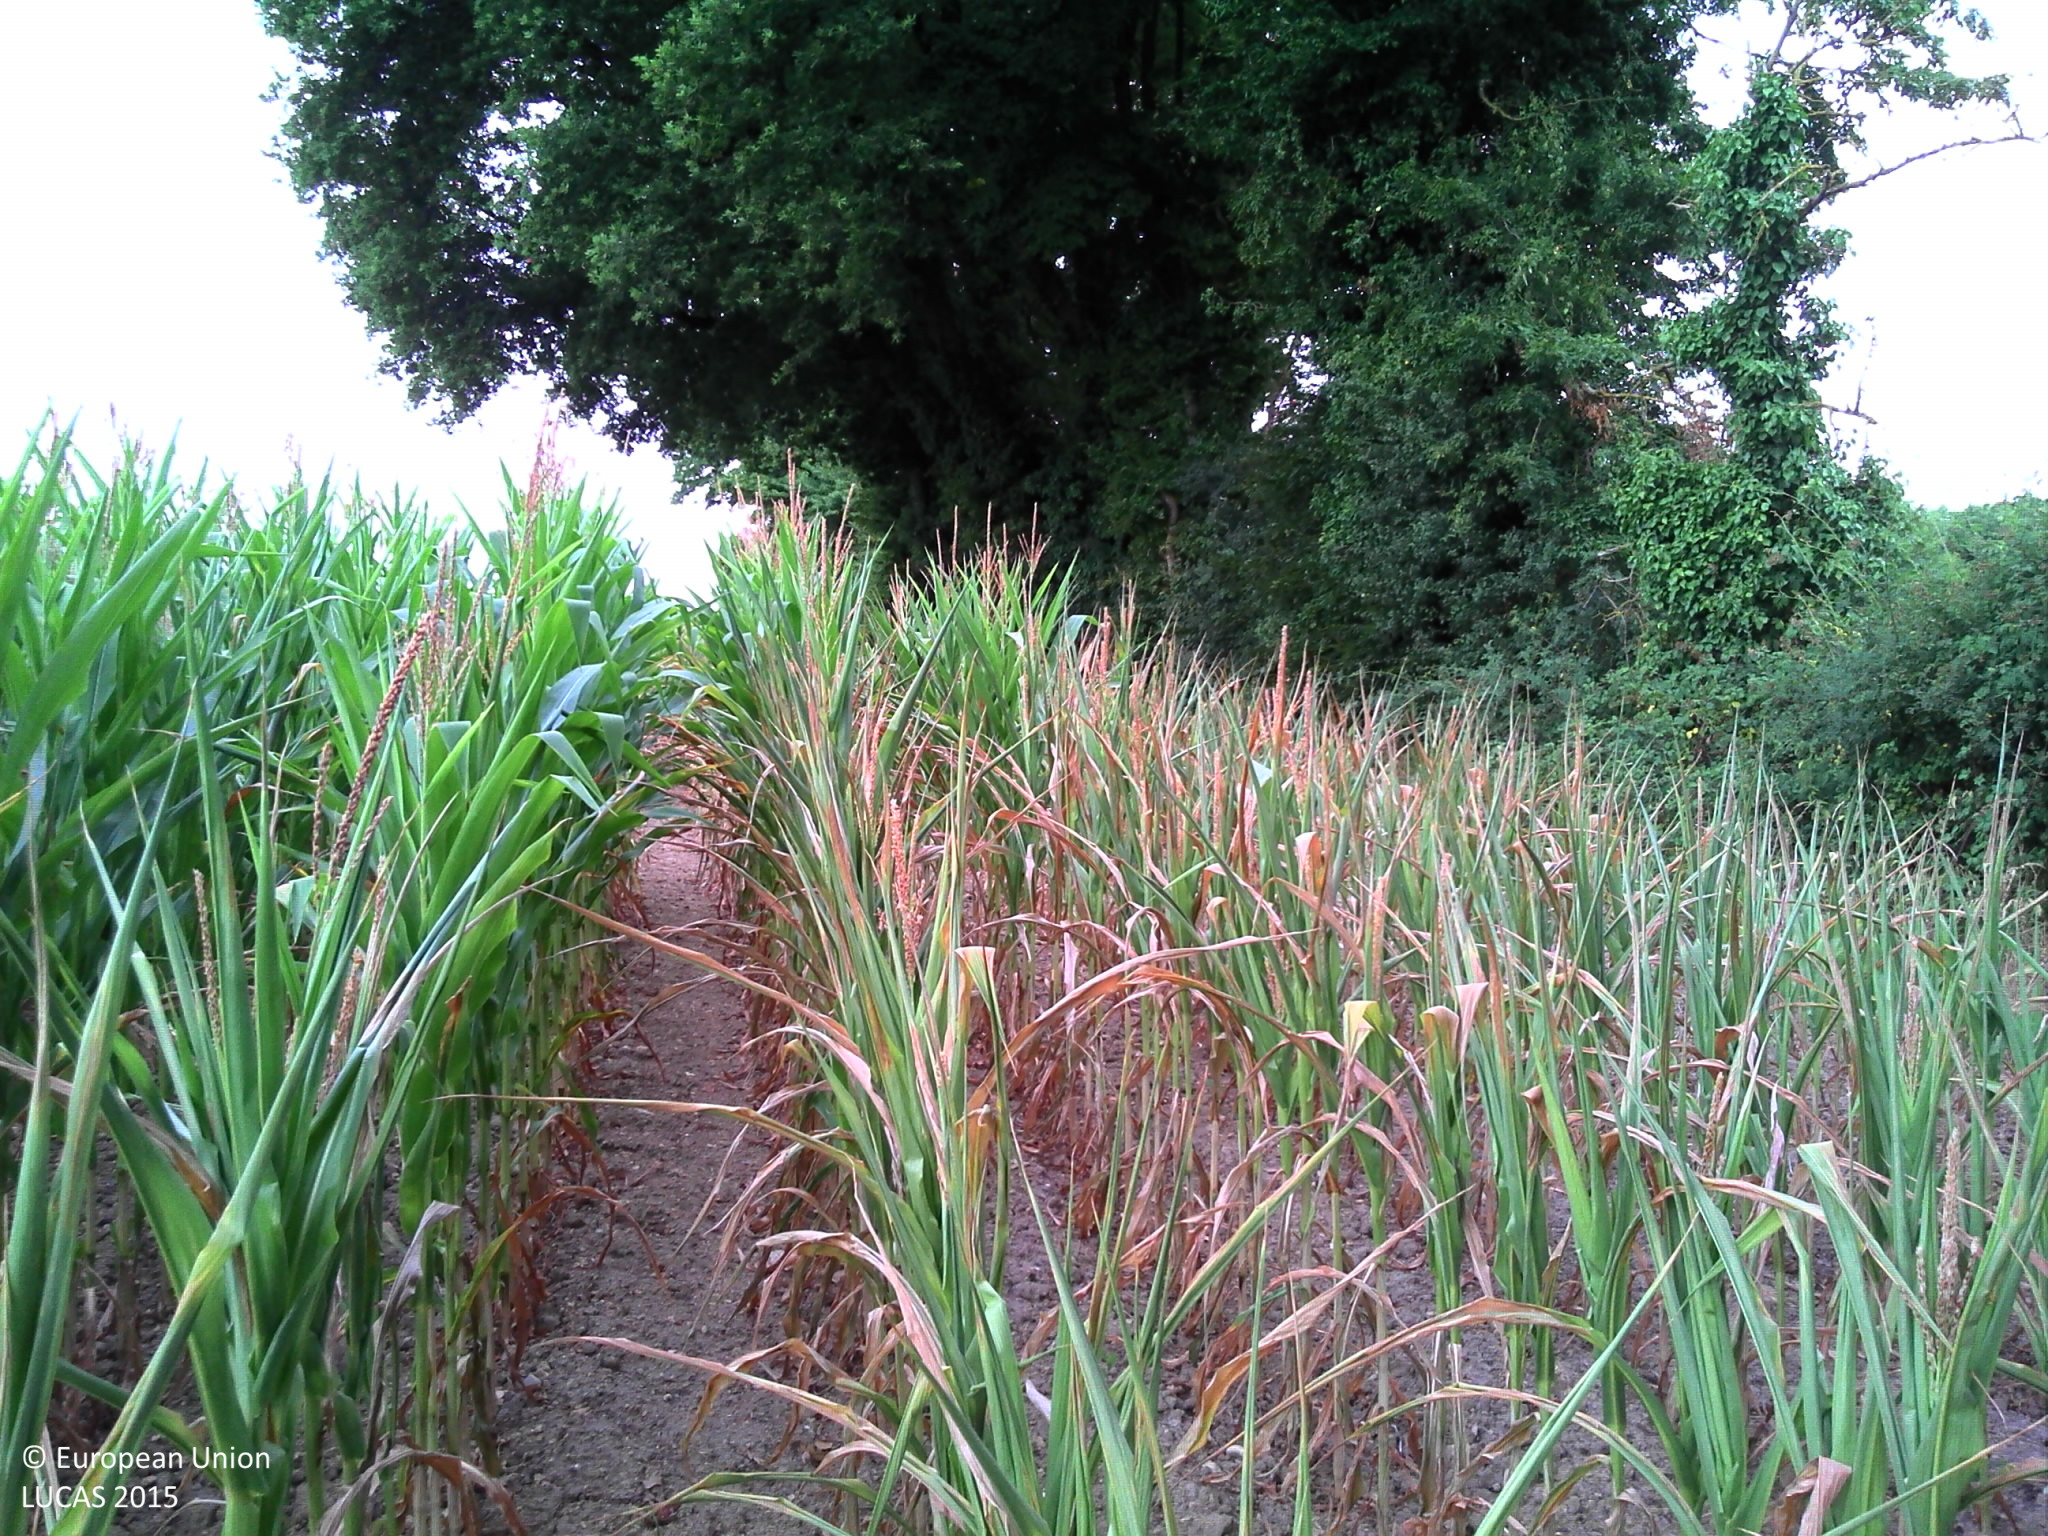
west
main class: Cropland
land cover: Maize
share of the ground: > 75 %
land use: Agriculture (excluding fallow land and kitchen gardens)
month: July
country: FR
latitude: 46.2718
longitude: 0.4980
